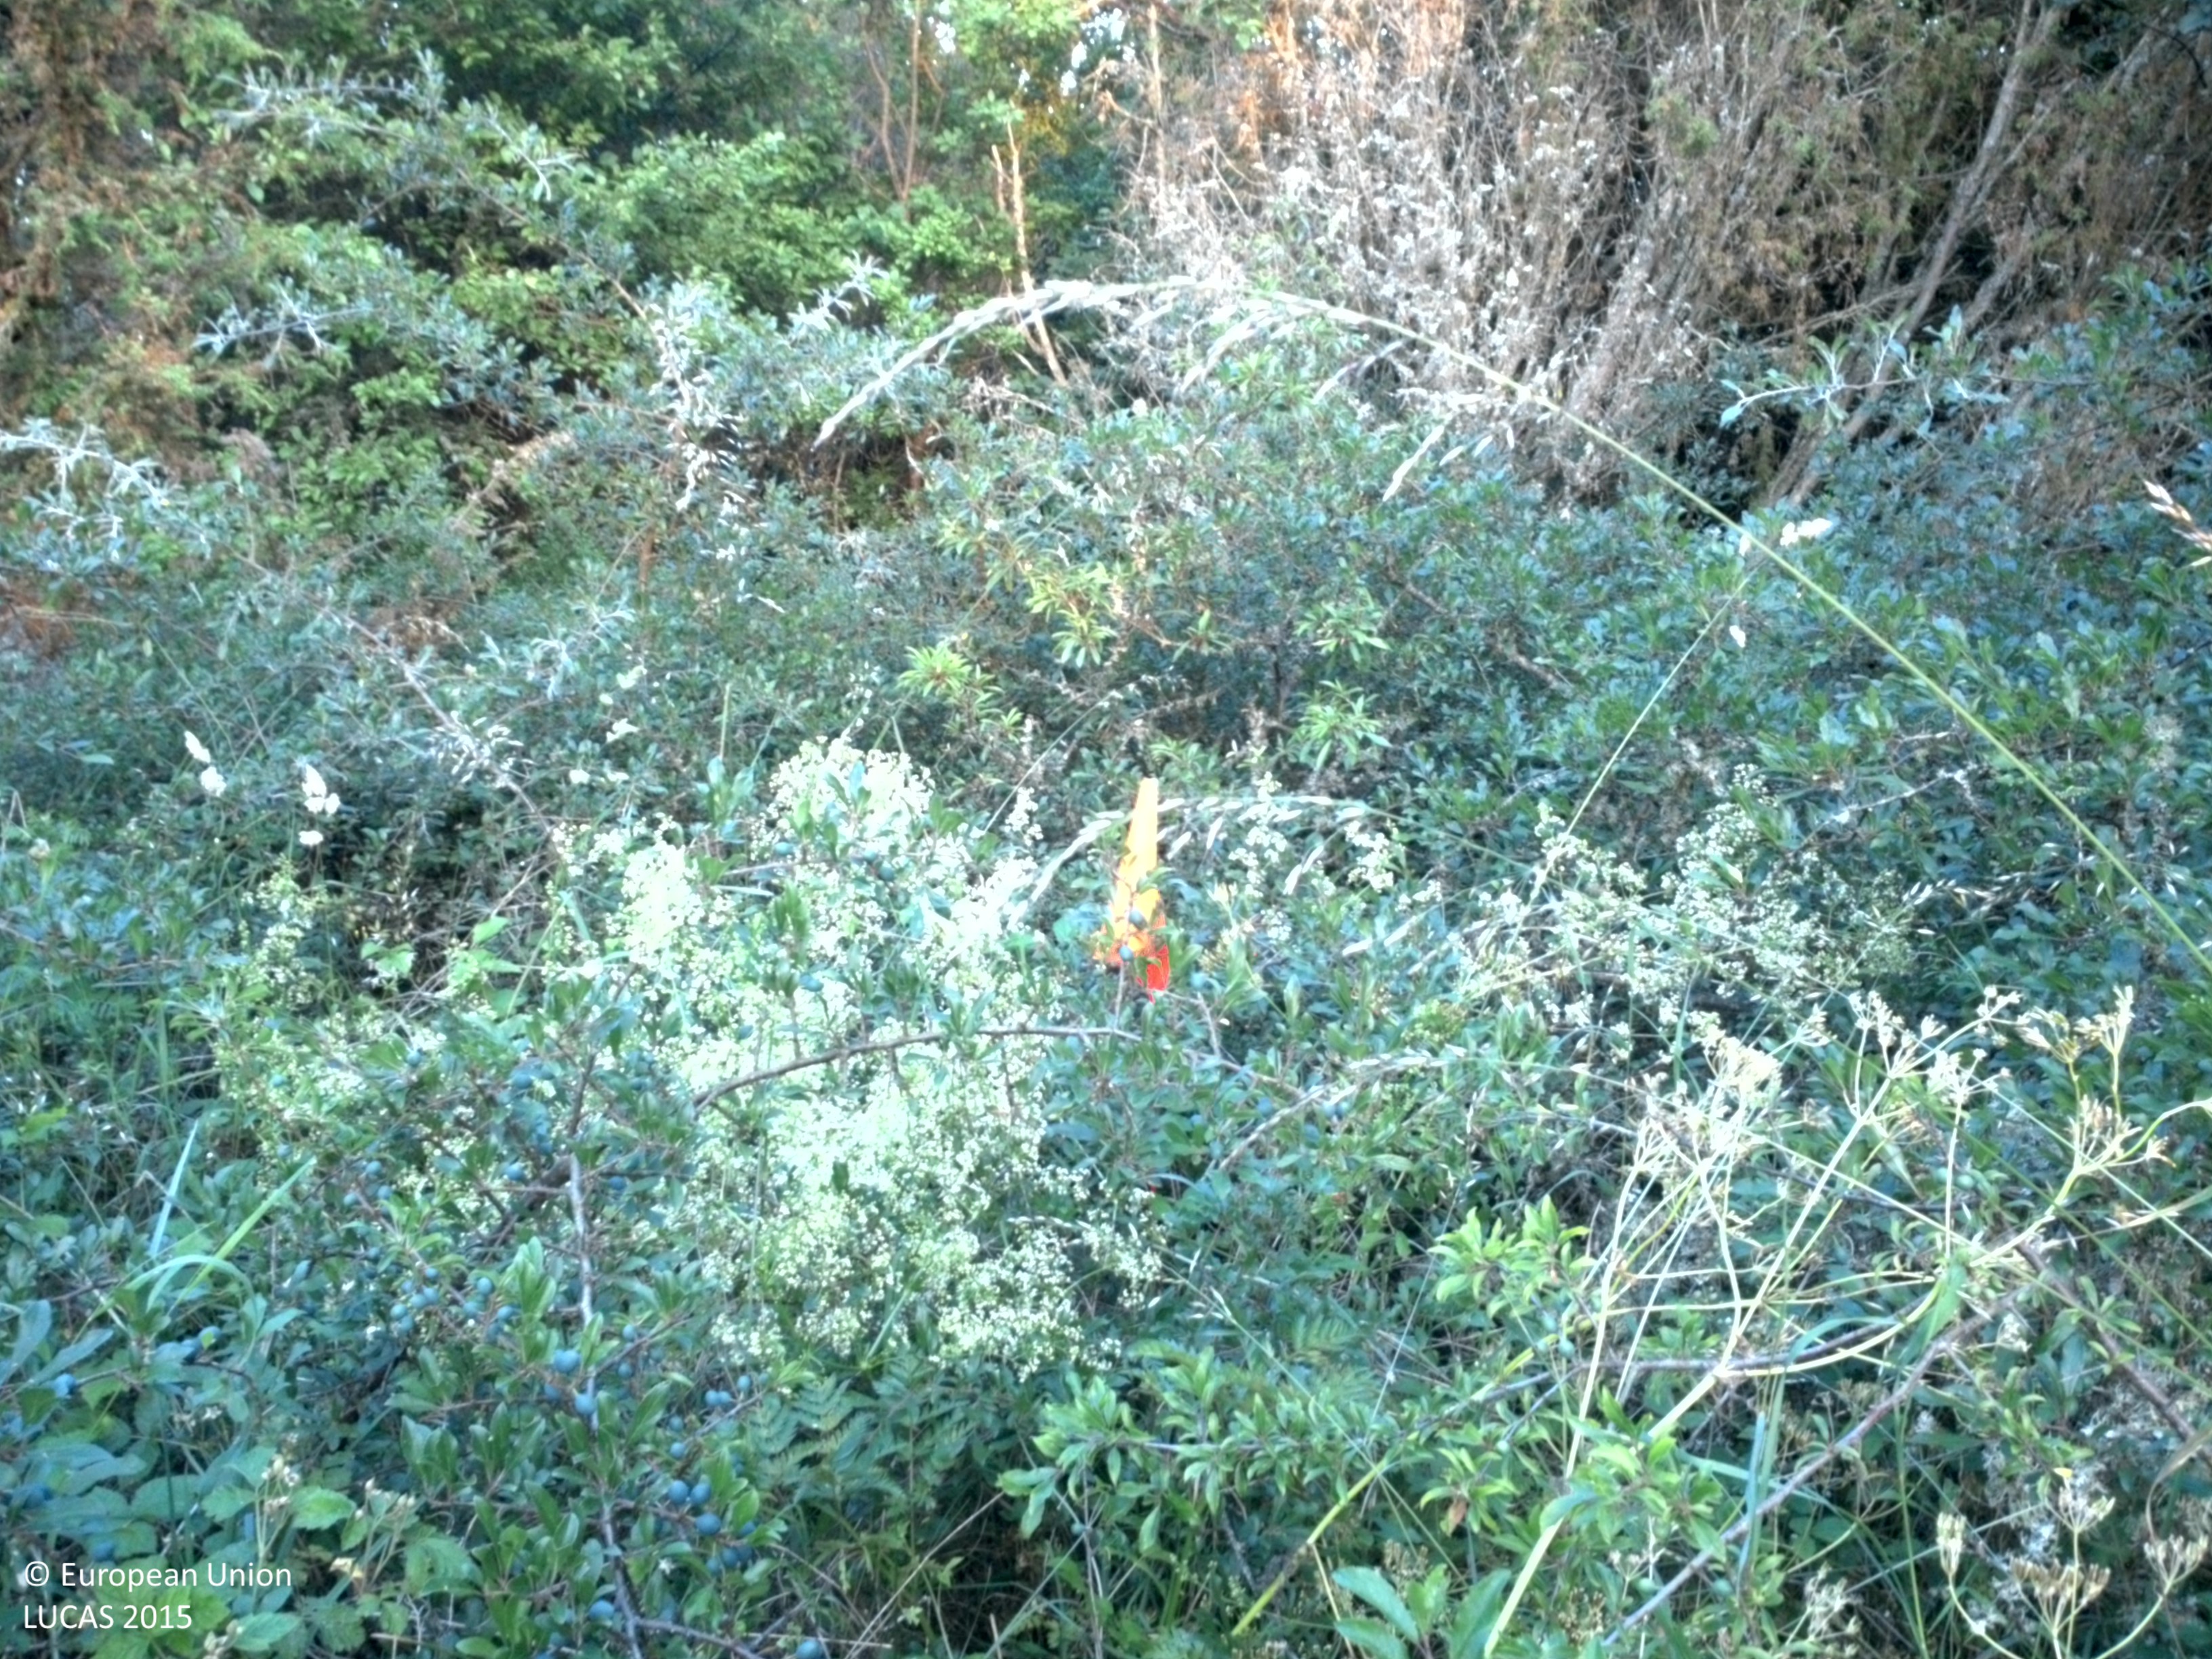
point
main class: Shrubland
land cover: Shrubland with sparse tree cover
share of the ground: > 75 %
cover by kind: shrubs 95 %, broadleaved forest trees 5 %
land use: Amenities, museums, leisure
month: July
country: SE
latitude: 57.6427
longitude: 18.7716
